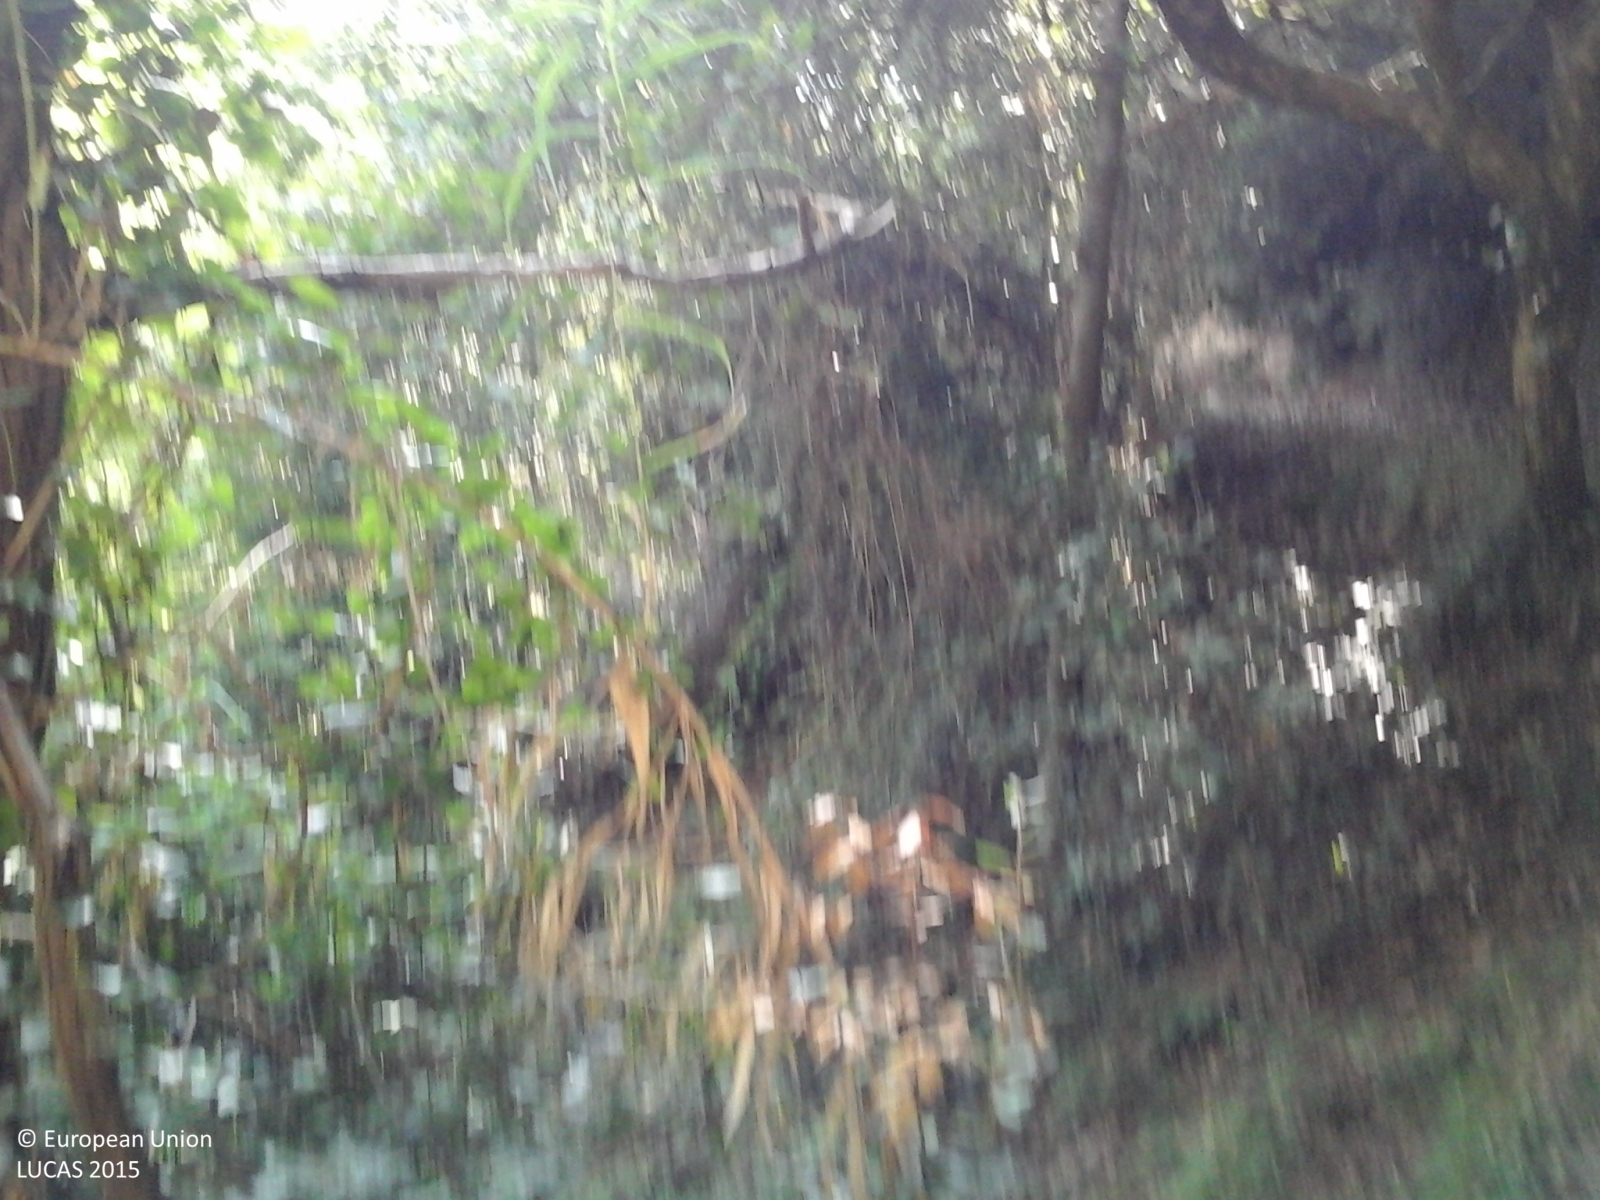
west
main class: Woodland
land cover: Broadleaved woodland
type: thermophilous deciduous forest
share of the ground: > 75 %
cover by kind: broadleaved forest trees 80 %, shrubs 10 %, herbaceous plants 10 %
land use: Semi-natural and natural areas not in use
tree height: > 5 m
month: September
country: IT
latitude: 44.3395
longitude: 8.4858
